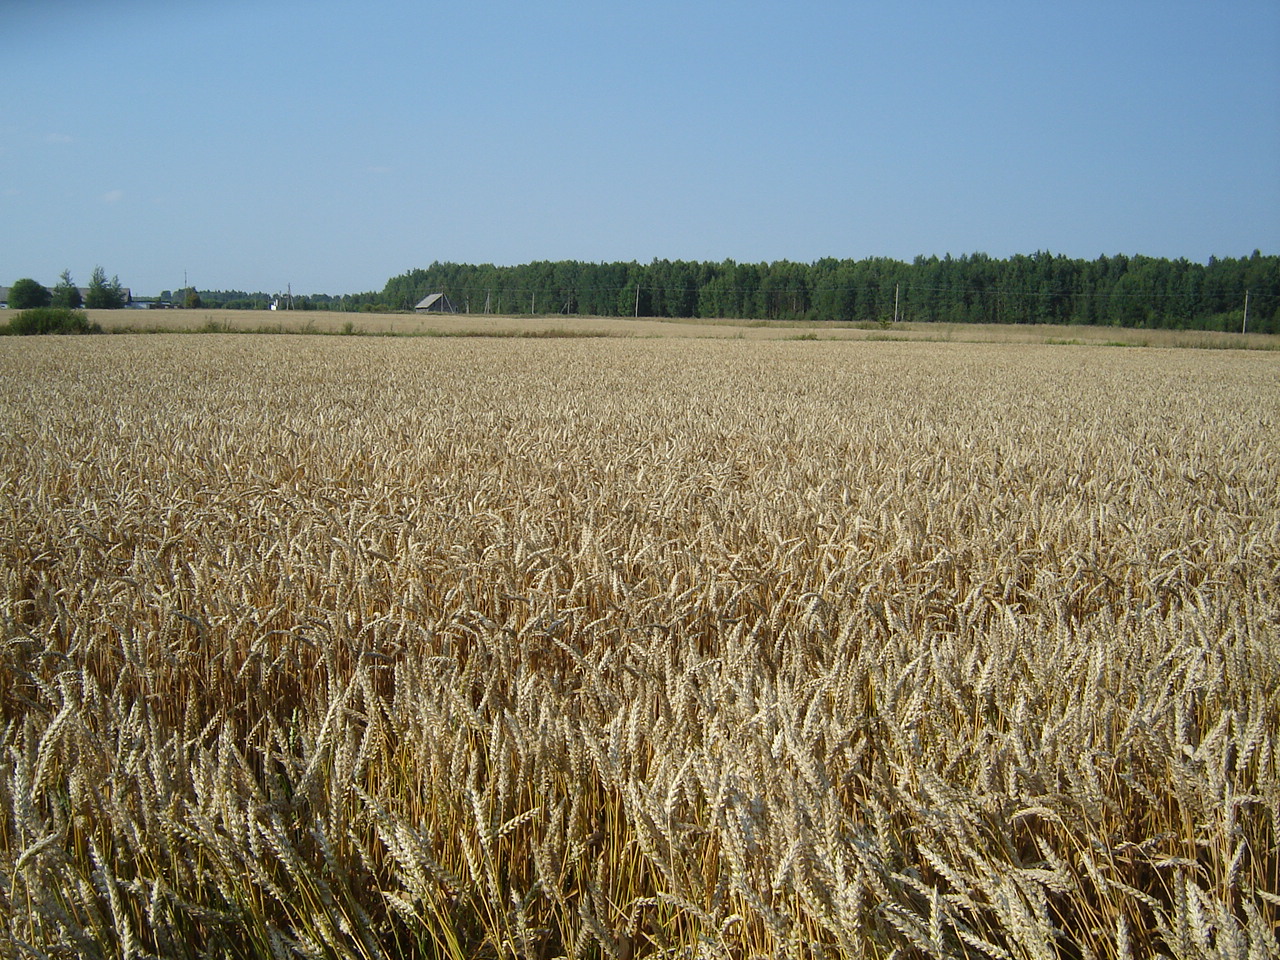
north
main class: Cropland
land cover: Common wheat
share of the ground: > 75 %
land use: Agriculture (excluding fallow land and kitchen gardens)
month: August
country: LT
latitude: 55.0852
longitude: 24.9479
